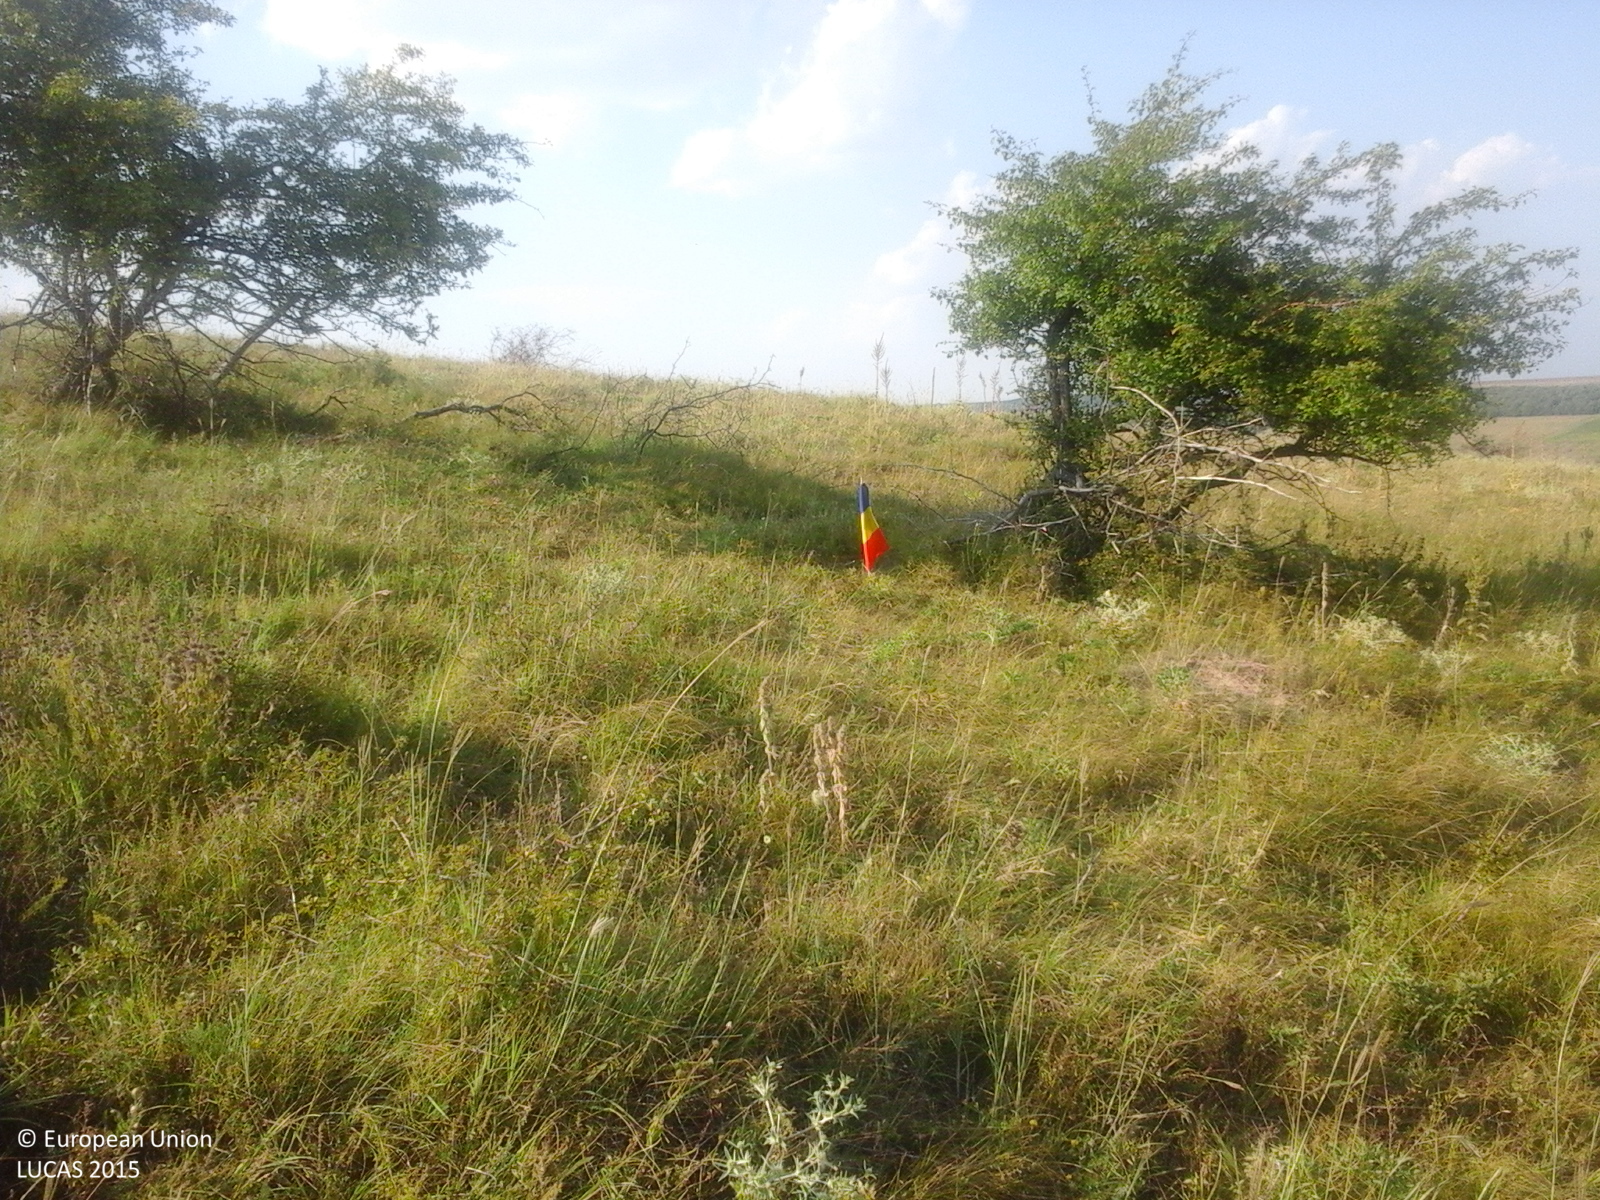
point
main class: Grassland
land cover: Grassland with sparse tree/shrub cover
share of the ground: > 75 %
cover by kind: herbaceous plants 85 %, shrubs 10 %, broadleaved forest trees 5 %
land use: Fallow land
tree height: > 5 m
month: July
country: RO
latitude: 46.5923
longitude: 28.0227
